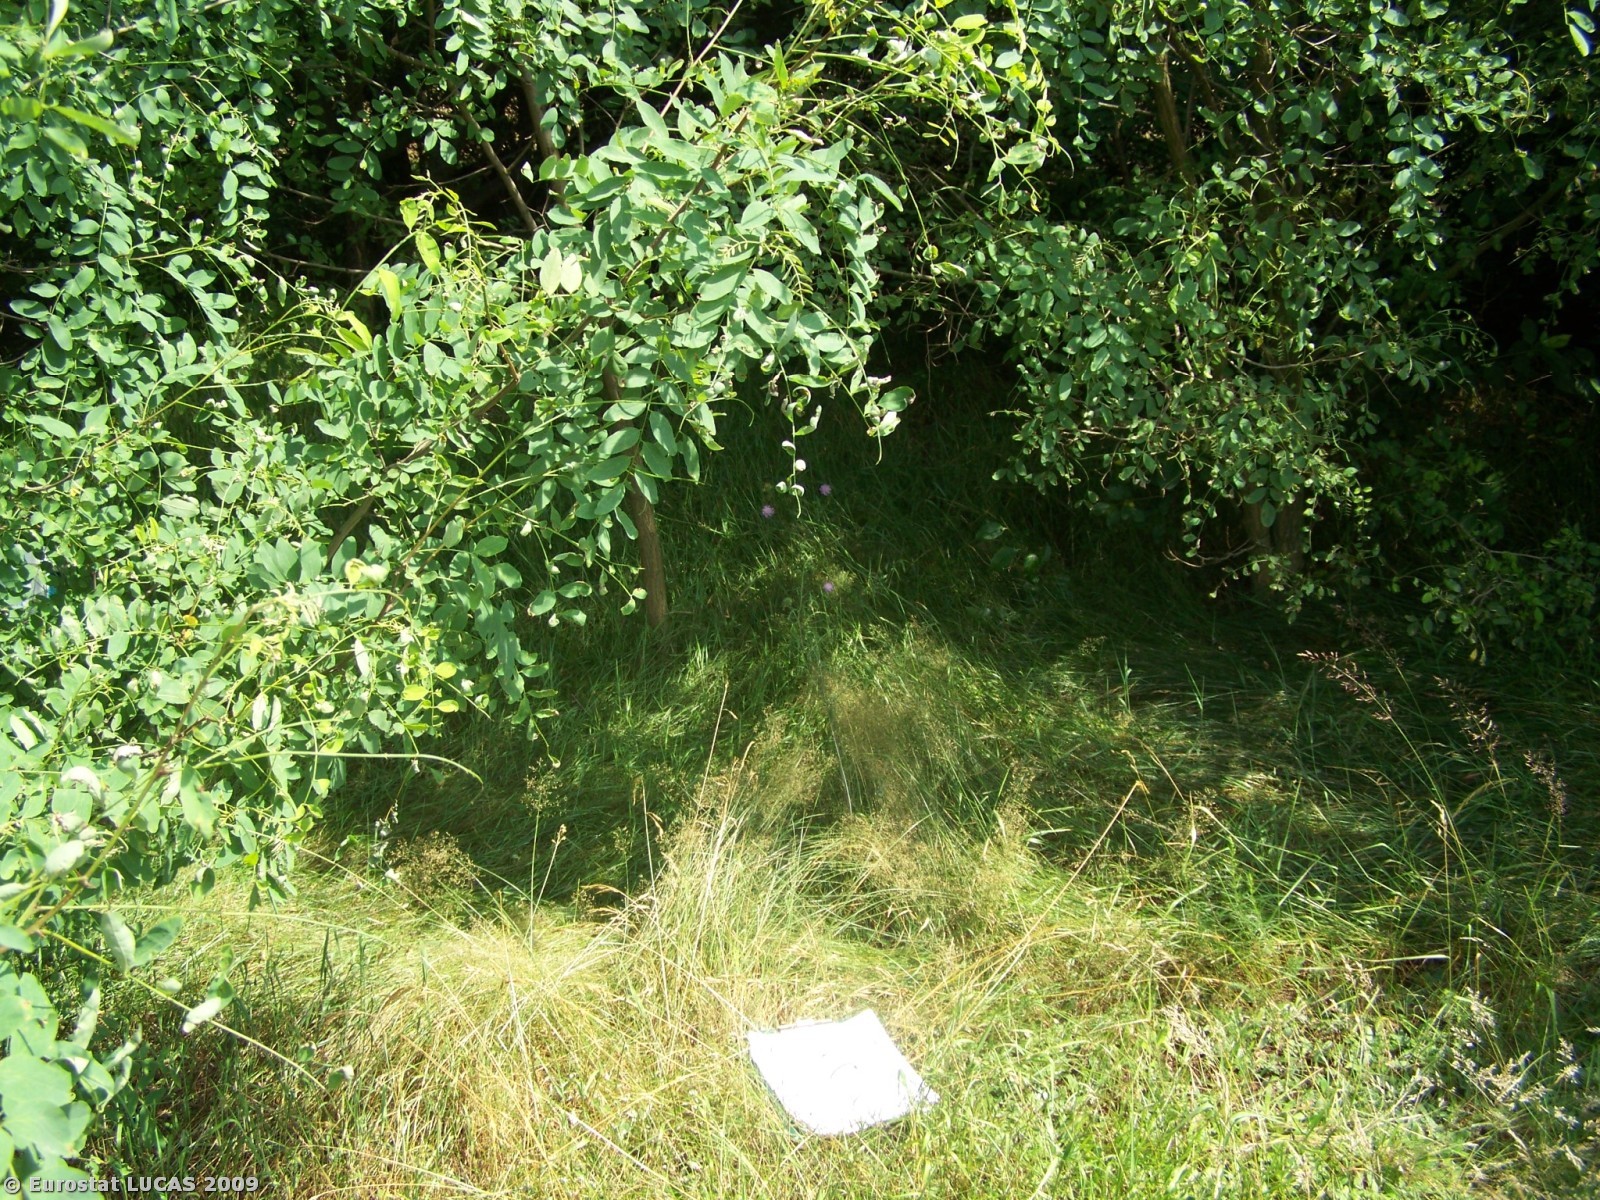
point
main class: Grassland
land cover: Grassland with sparse tree/shrub cover
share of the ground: > 75 %
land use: Unused
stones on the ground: < 10 %
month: July
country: PL
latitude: 52.0419
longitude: 22.1471
